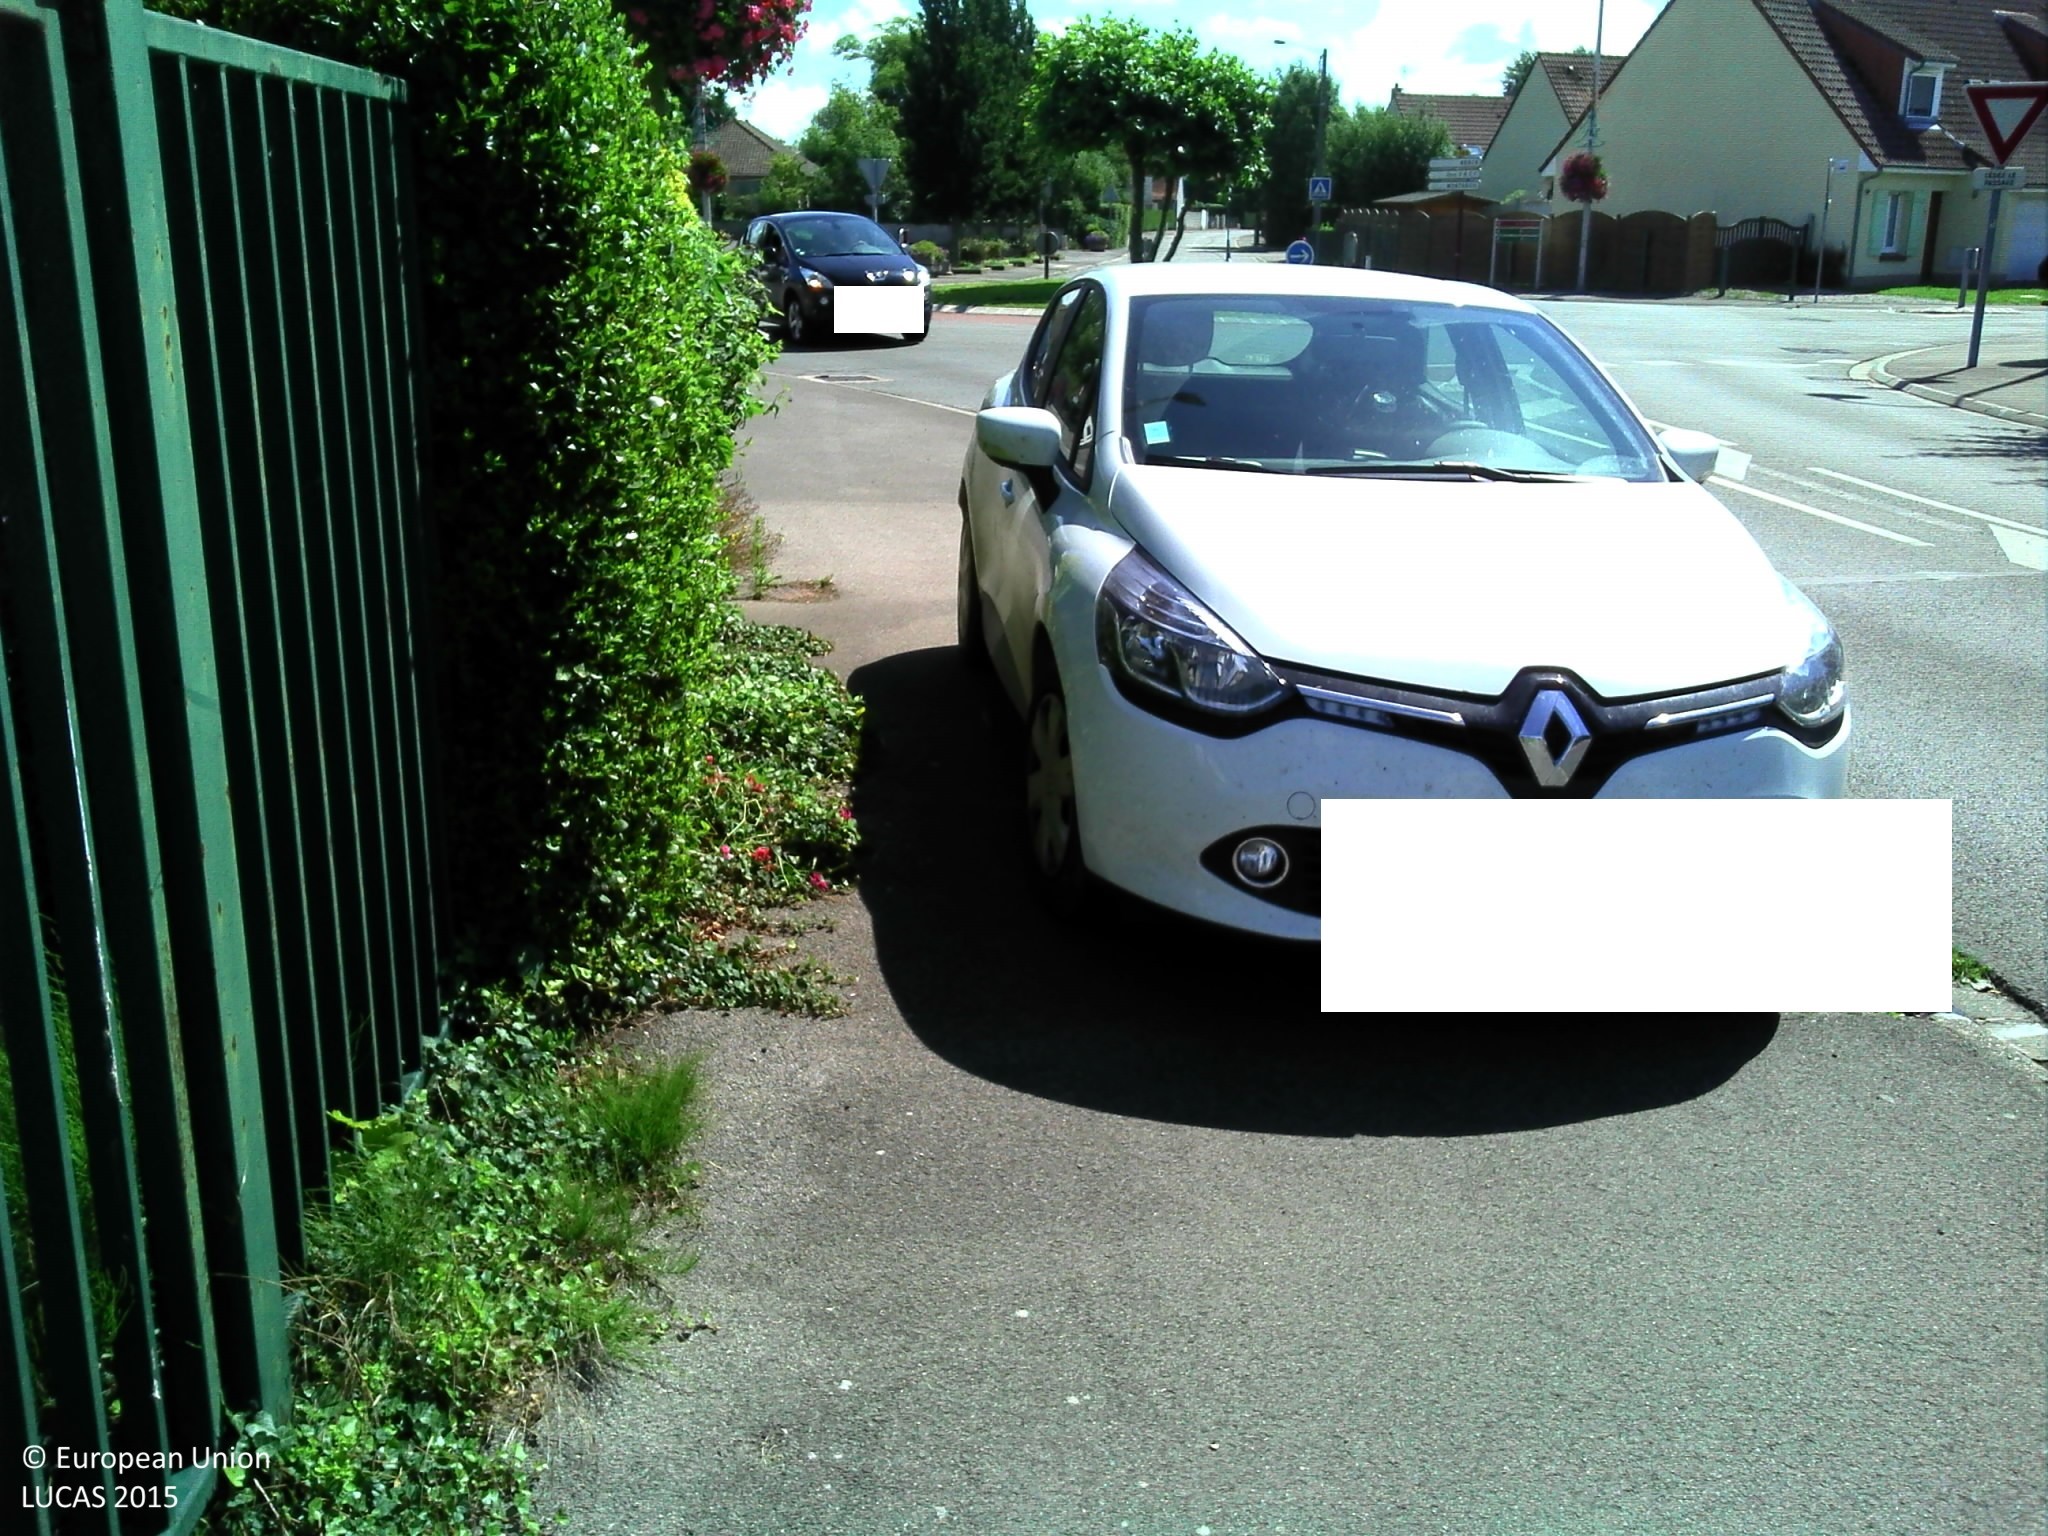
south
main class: Grassland
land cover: Spontaneously vegetated surfaces
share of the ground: > 75 %
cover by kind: herbaceous plants 100 %
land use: Semi-natural and natural areas not in use
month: July
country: FR
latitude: 50.4189
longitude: 1.6358
